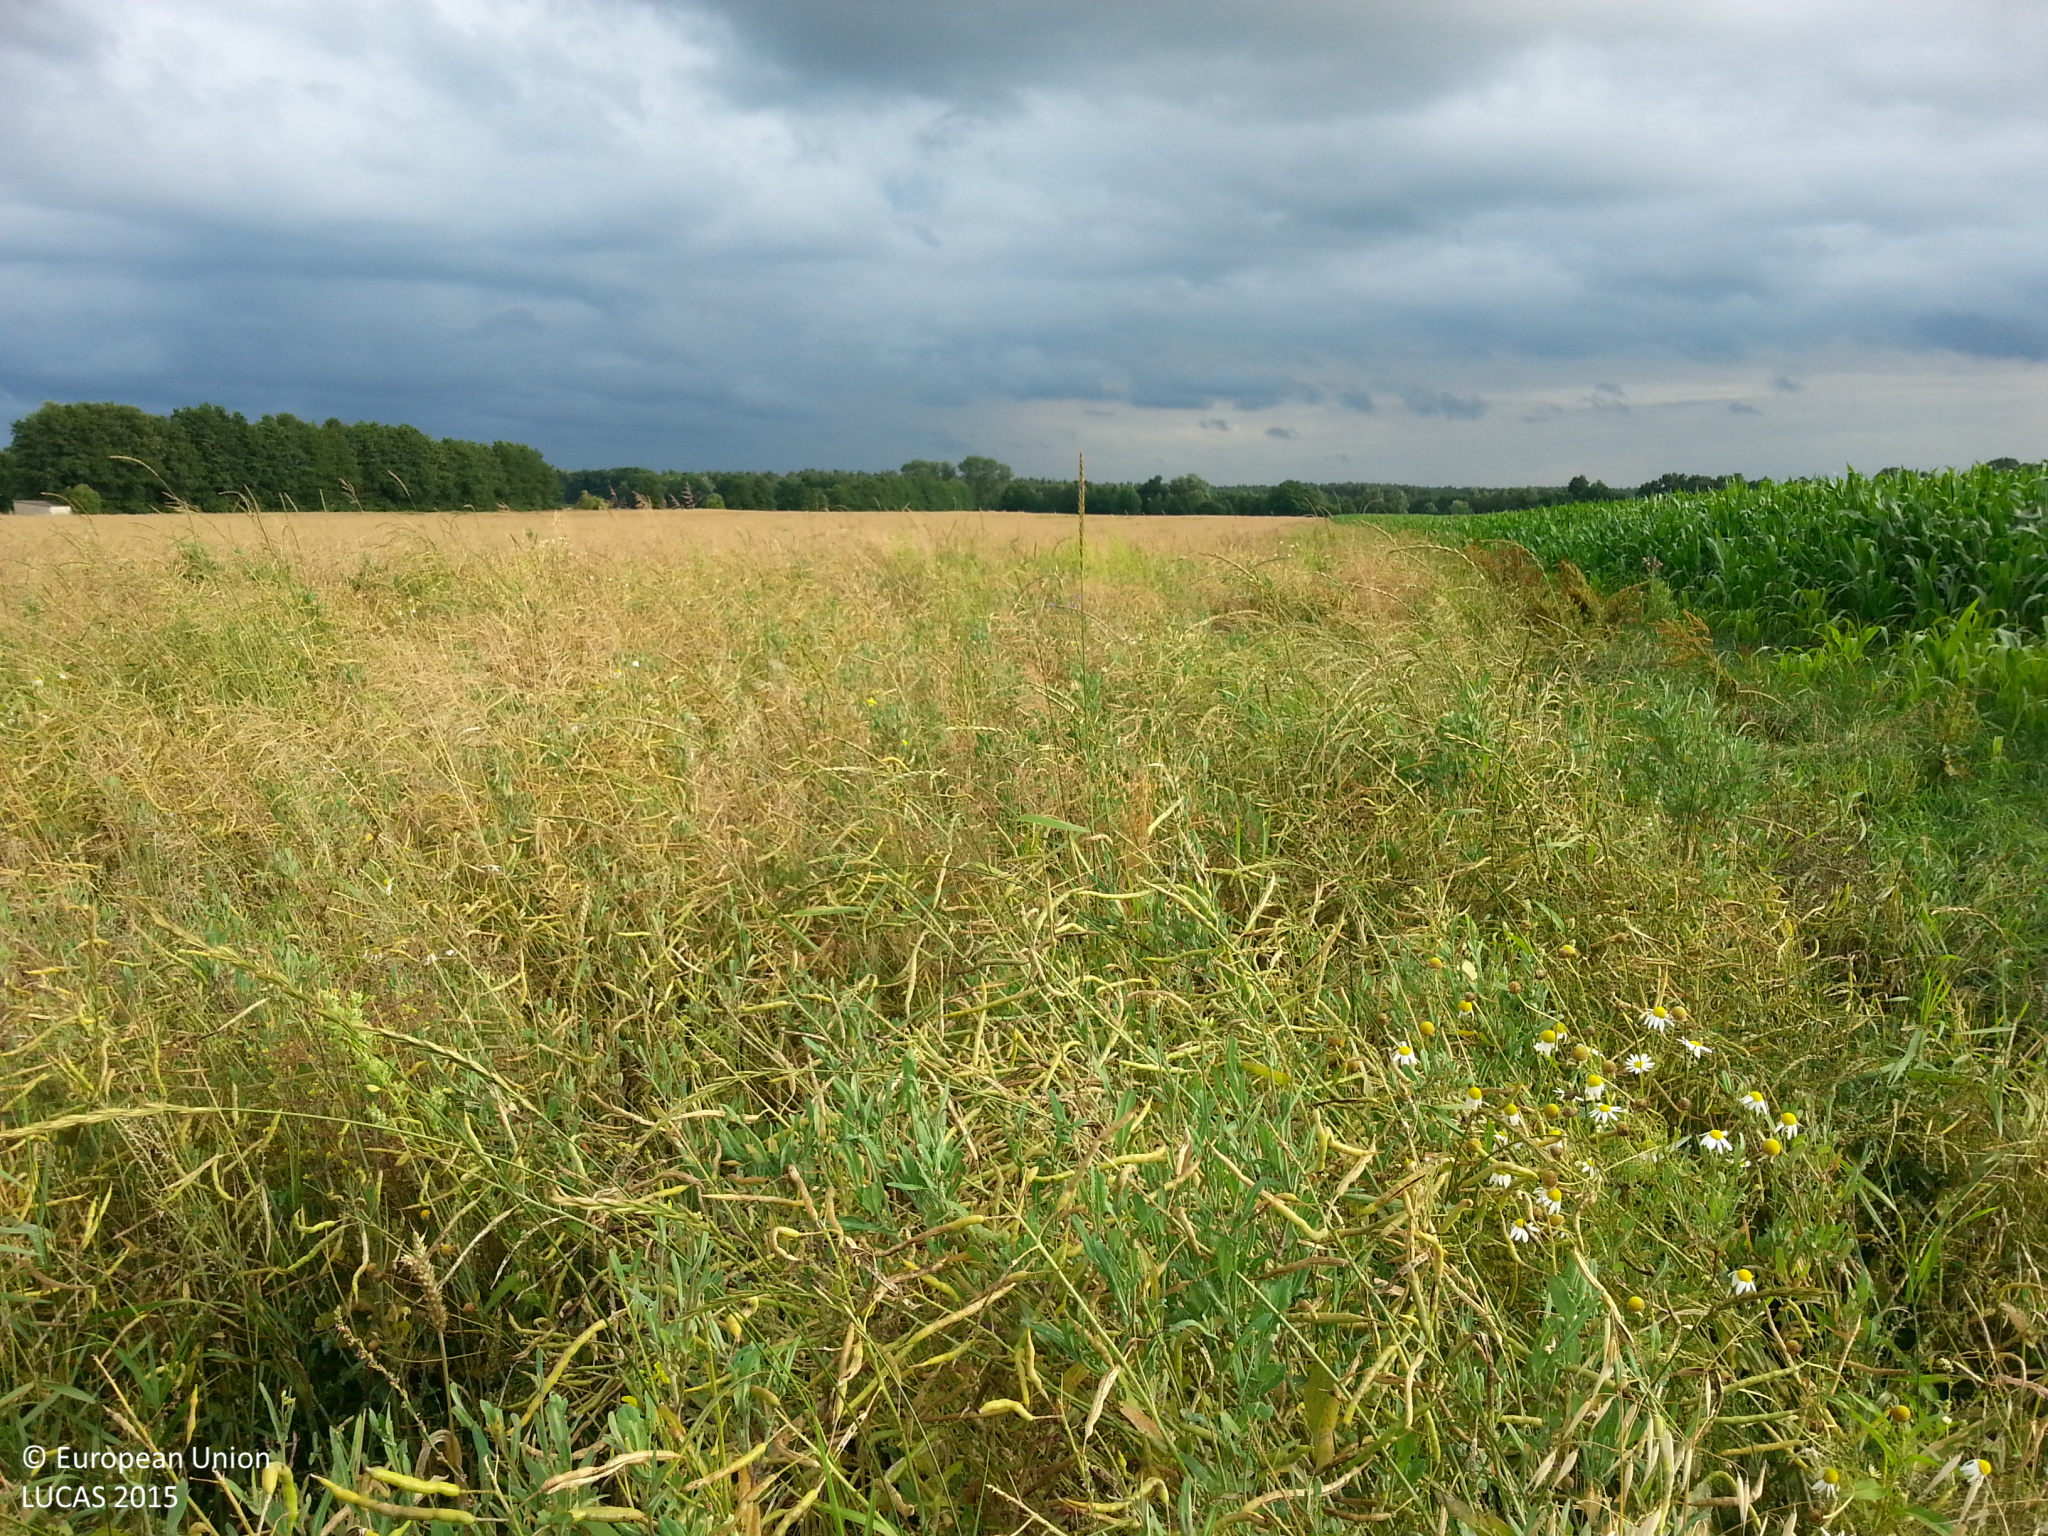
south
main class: Cropland
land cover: Rape and turnip rape
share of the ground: > 75 %
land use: Agriculture (excluding fallow land and kitchen gardens)
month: July
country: DE
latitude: 53.1257
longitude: 12.4353
